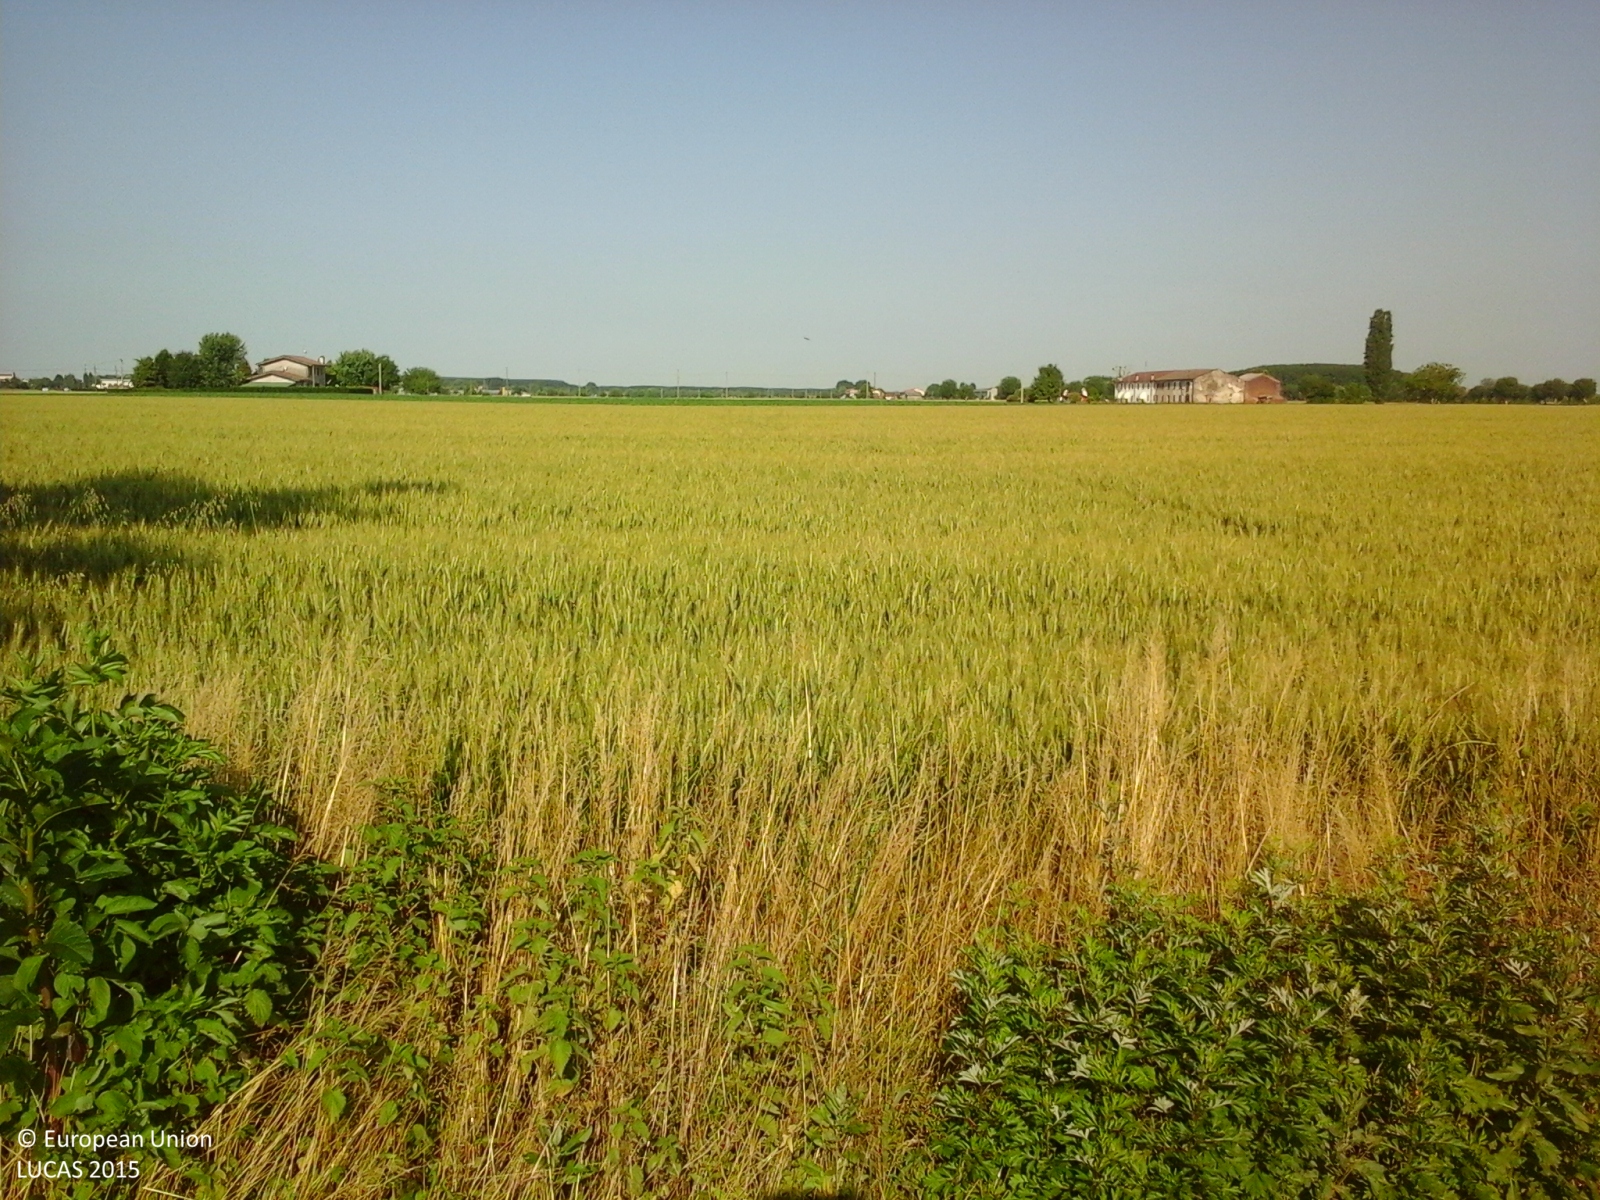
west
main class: Cropland
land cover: Common wheat
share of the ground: > 75 %
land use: Agriculture (excluding fallow land and kitchen gardens)
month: May
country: IT
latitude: 45.1930
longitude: 11.0291
